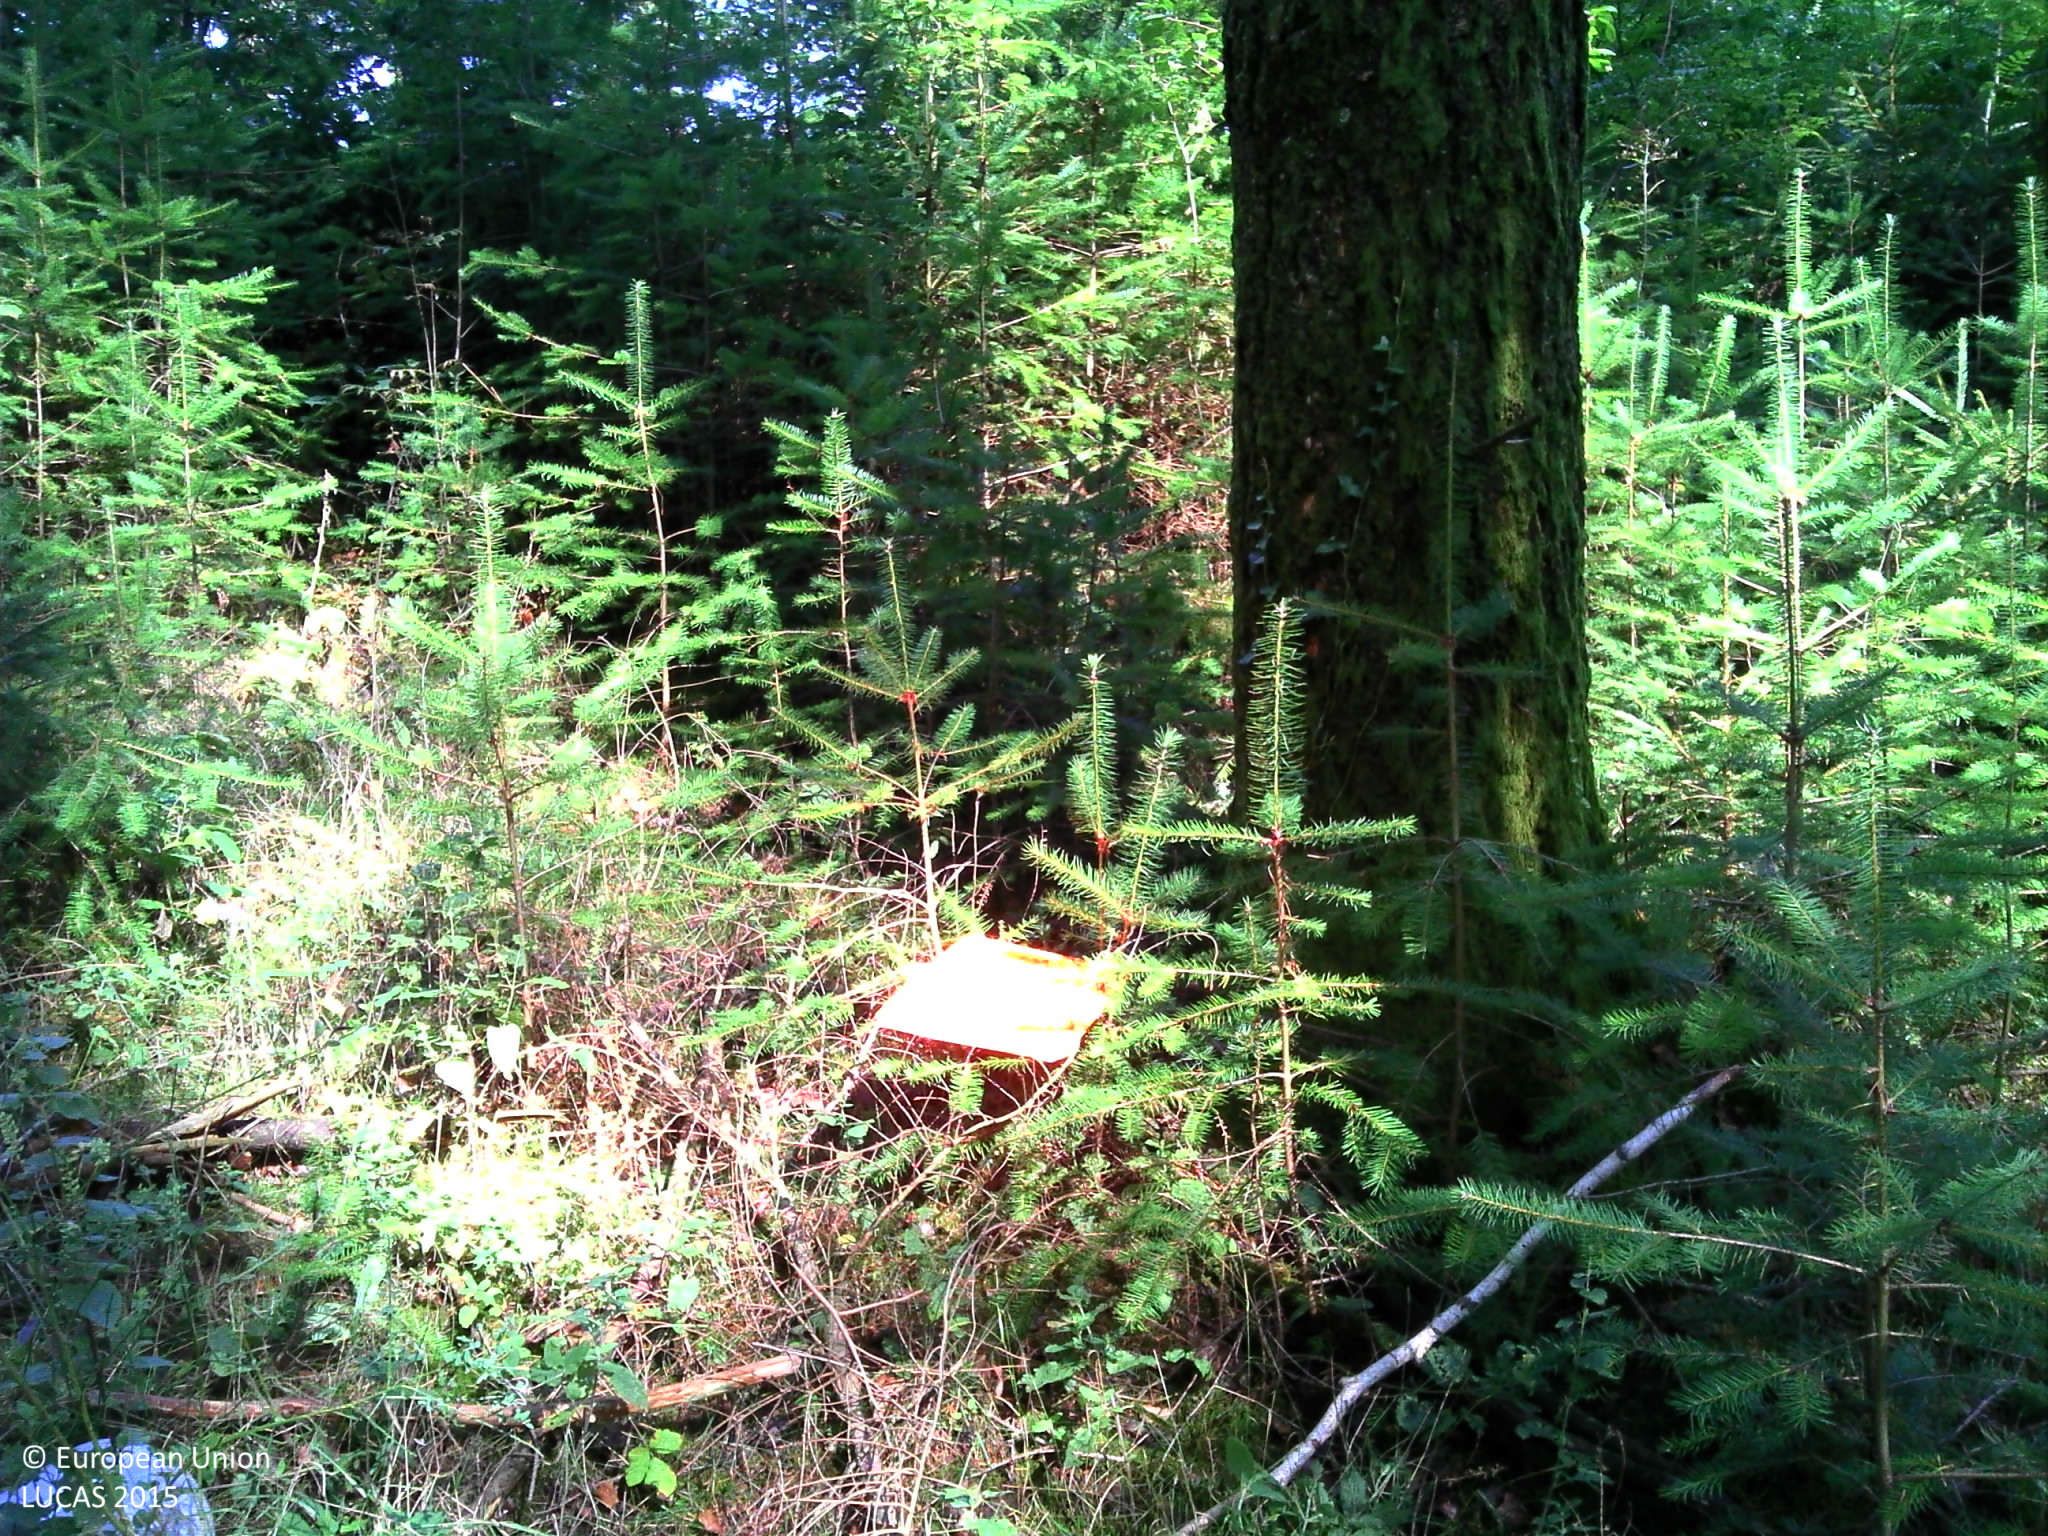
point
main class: Woodland
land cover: Other coniferous woodland
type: exotic forest
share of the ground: > 75 %
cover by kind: coniferous forest trees 65 %, herbaceous plants 35 %
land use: Forestry
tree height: > 5 m
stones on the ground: < 10 %
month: August
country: FR
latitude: 45.6554
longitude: 1.7943
